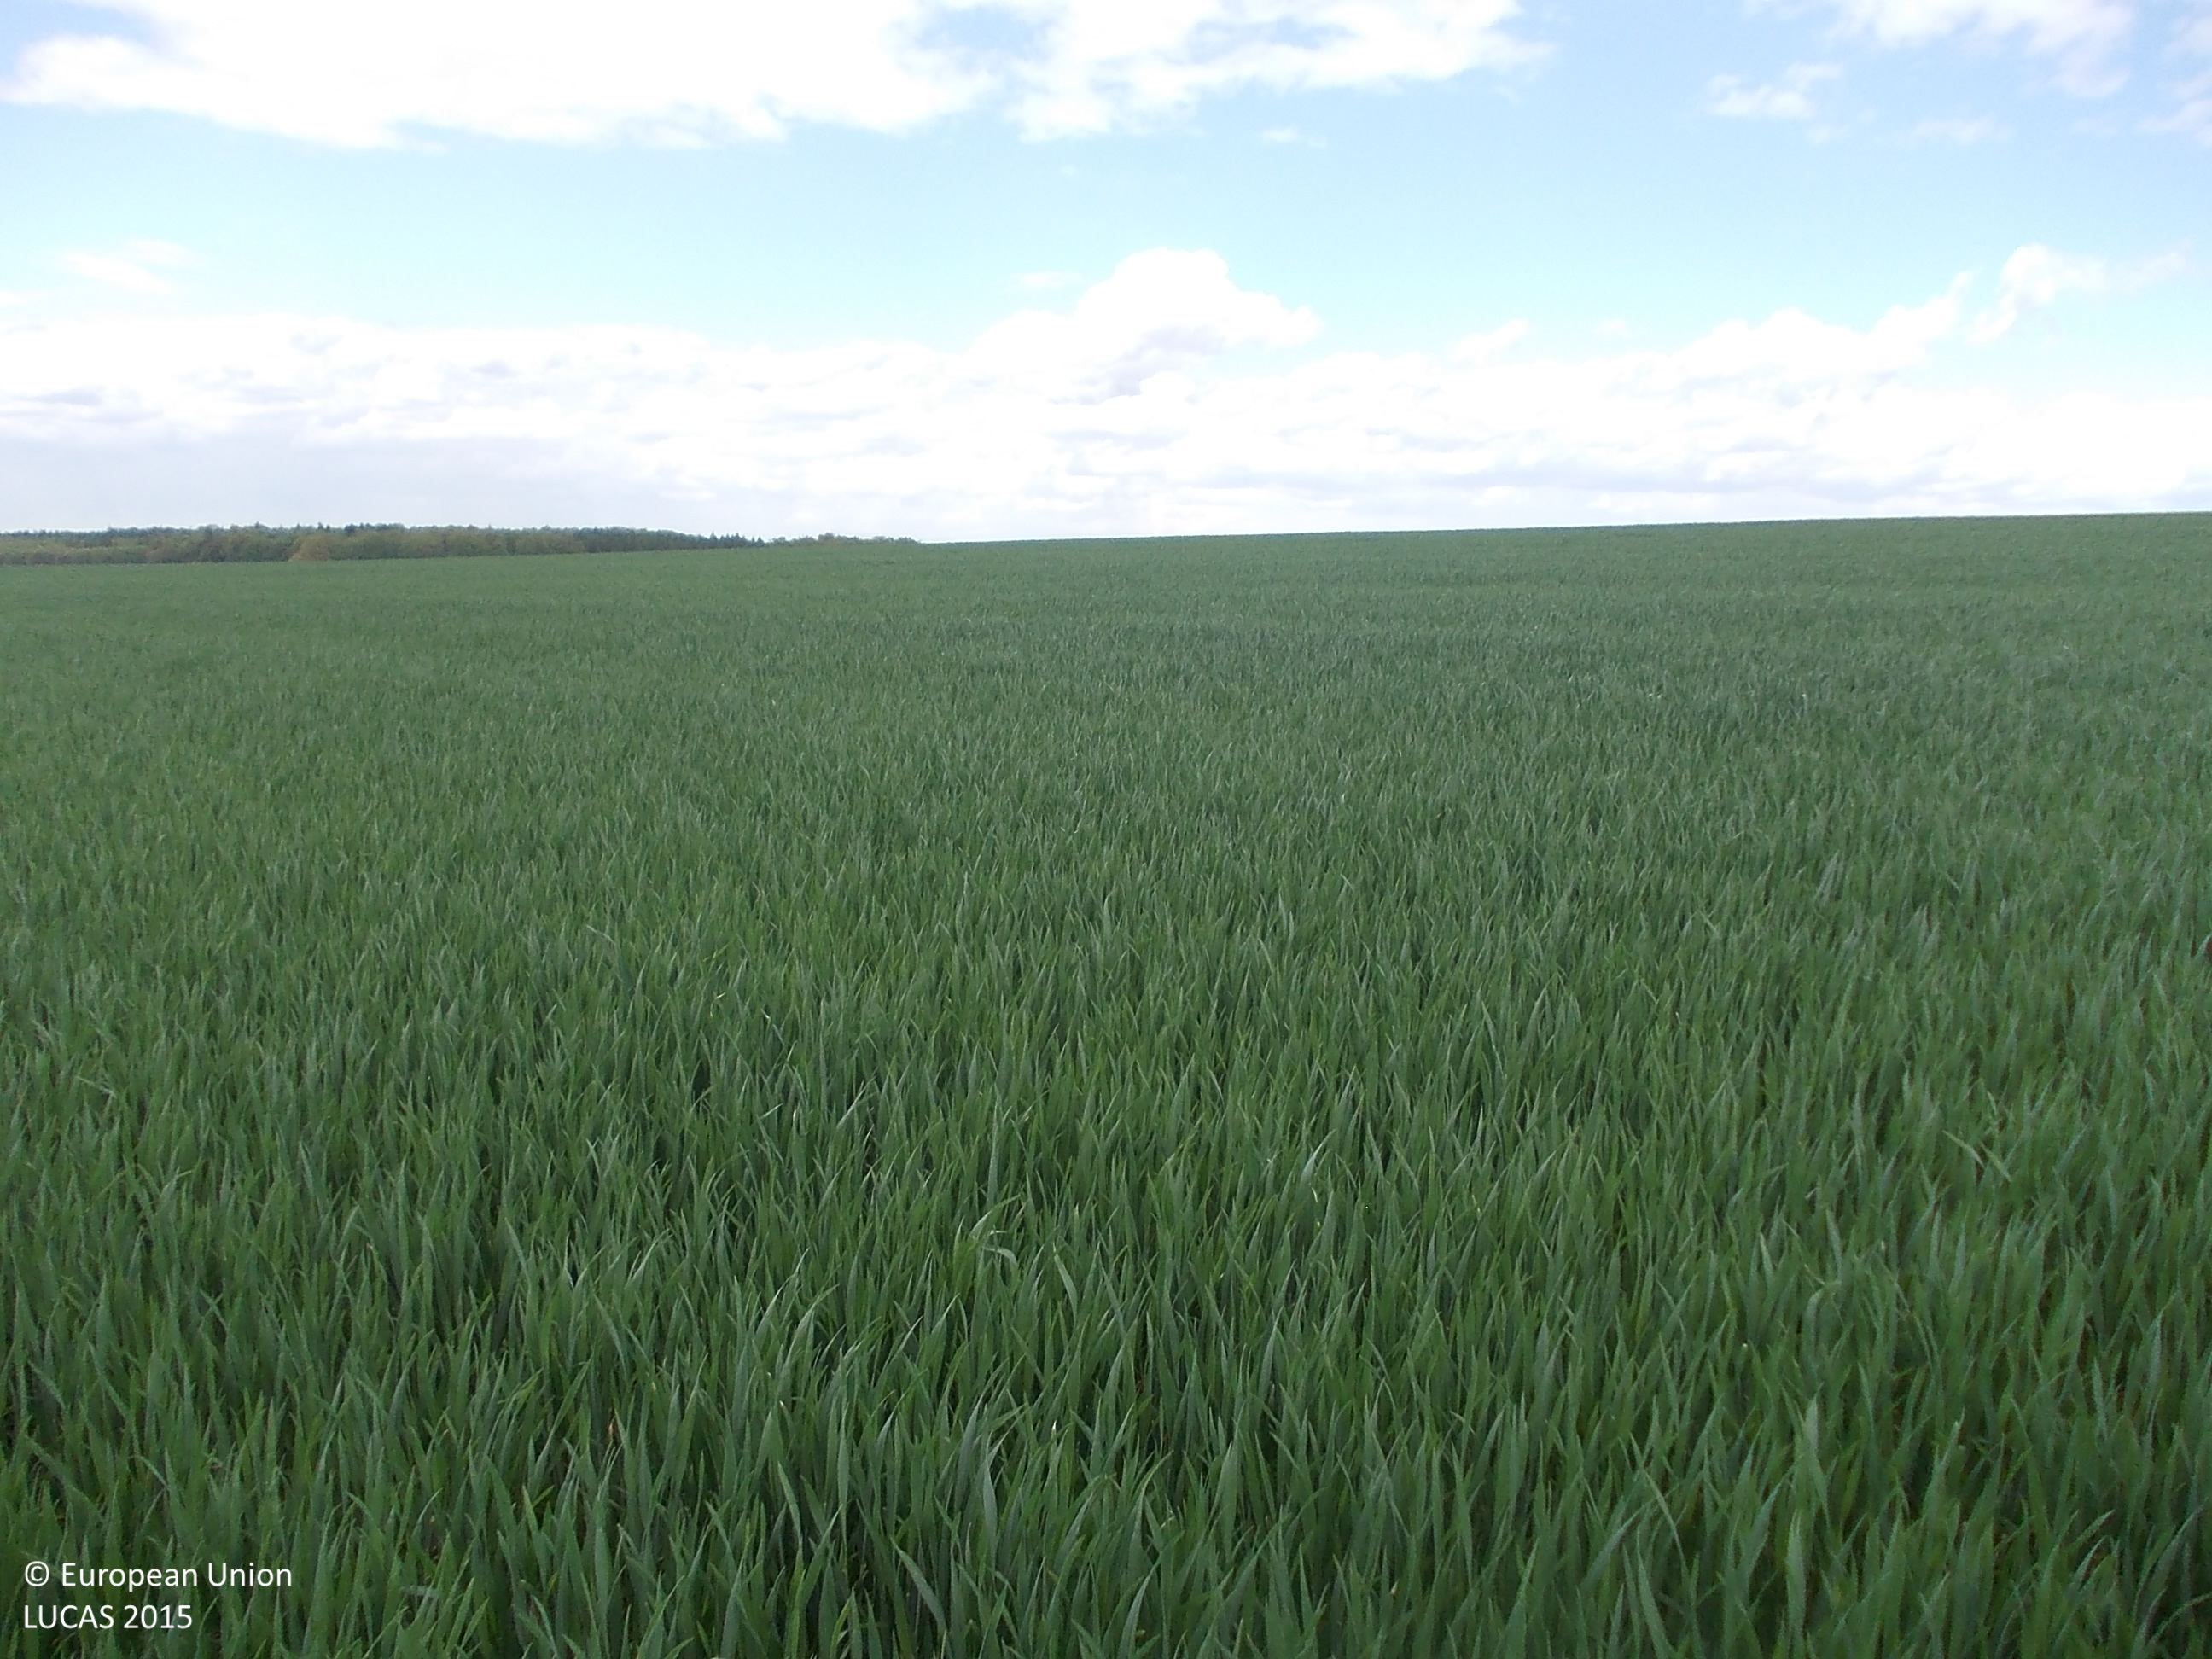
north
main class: Cropland
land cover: Common wheat
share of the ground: > 75 %
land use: Agriculture (excluding fallow land and kitchen gardens)
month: May
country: CZ
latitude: 50.2753
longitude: 15.7156
